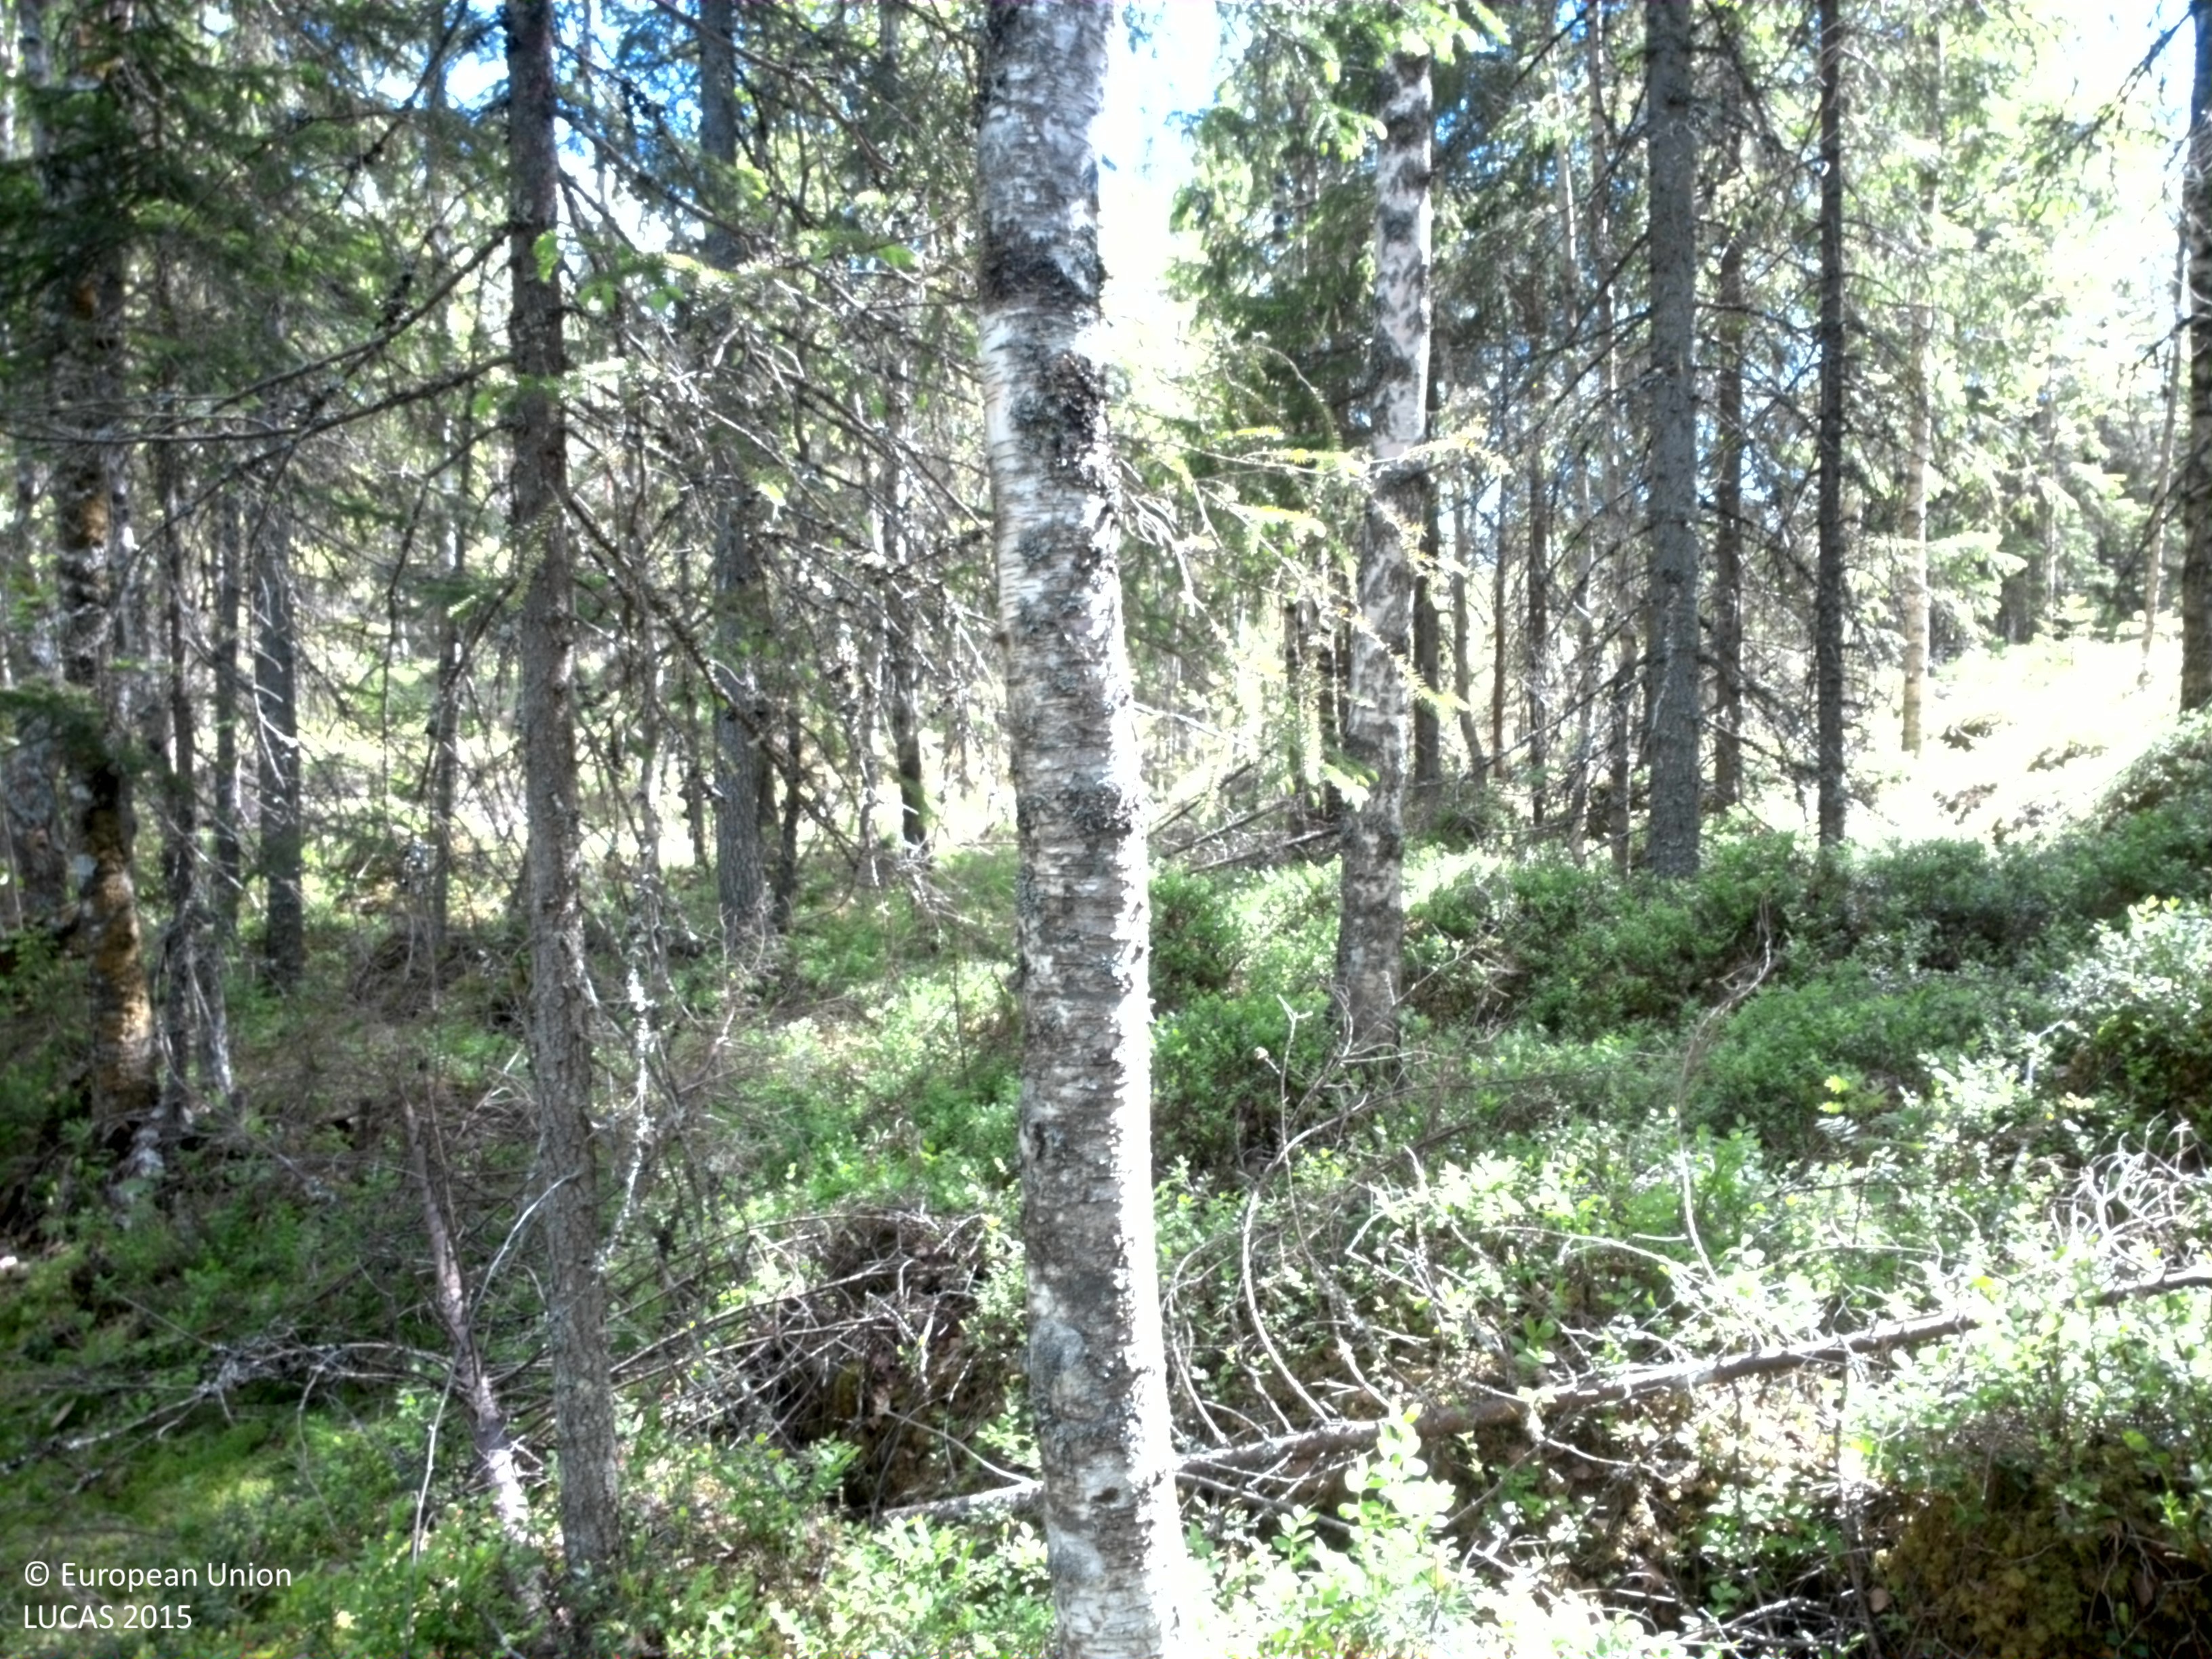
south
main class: Woodland
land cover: Pine dominated mixed woodland
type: boreal forest
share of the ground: 25 - 50 %
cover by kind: coniferous forest trees 35 %, lichens and mosses 25 %, shrubs 20 %, broadleaved forest trees 15 %, herbaceous plants 5 %
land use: Forestry
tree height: > 5 m
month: June
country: SE
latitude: 59.6258
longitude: 12.0335
